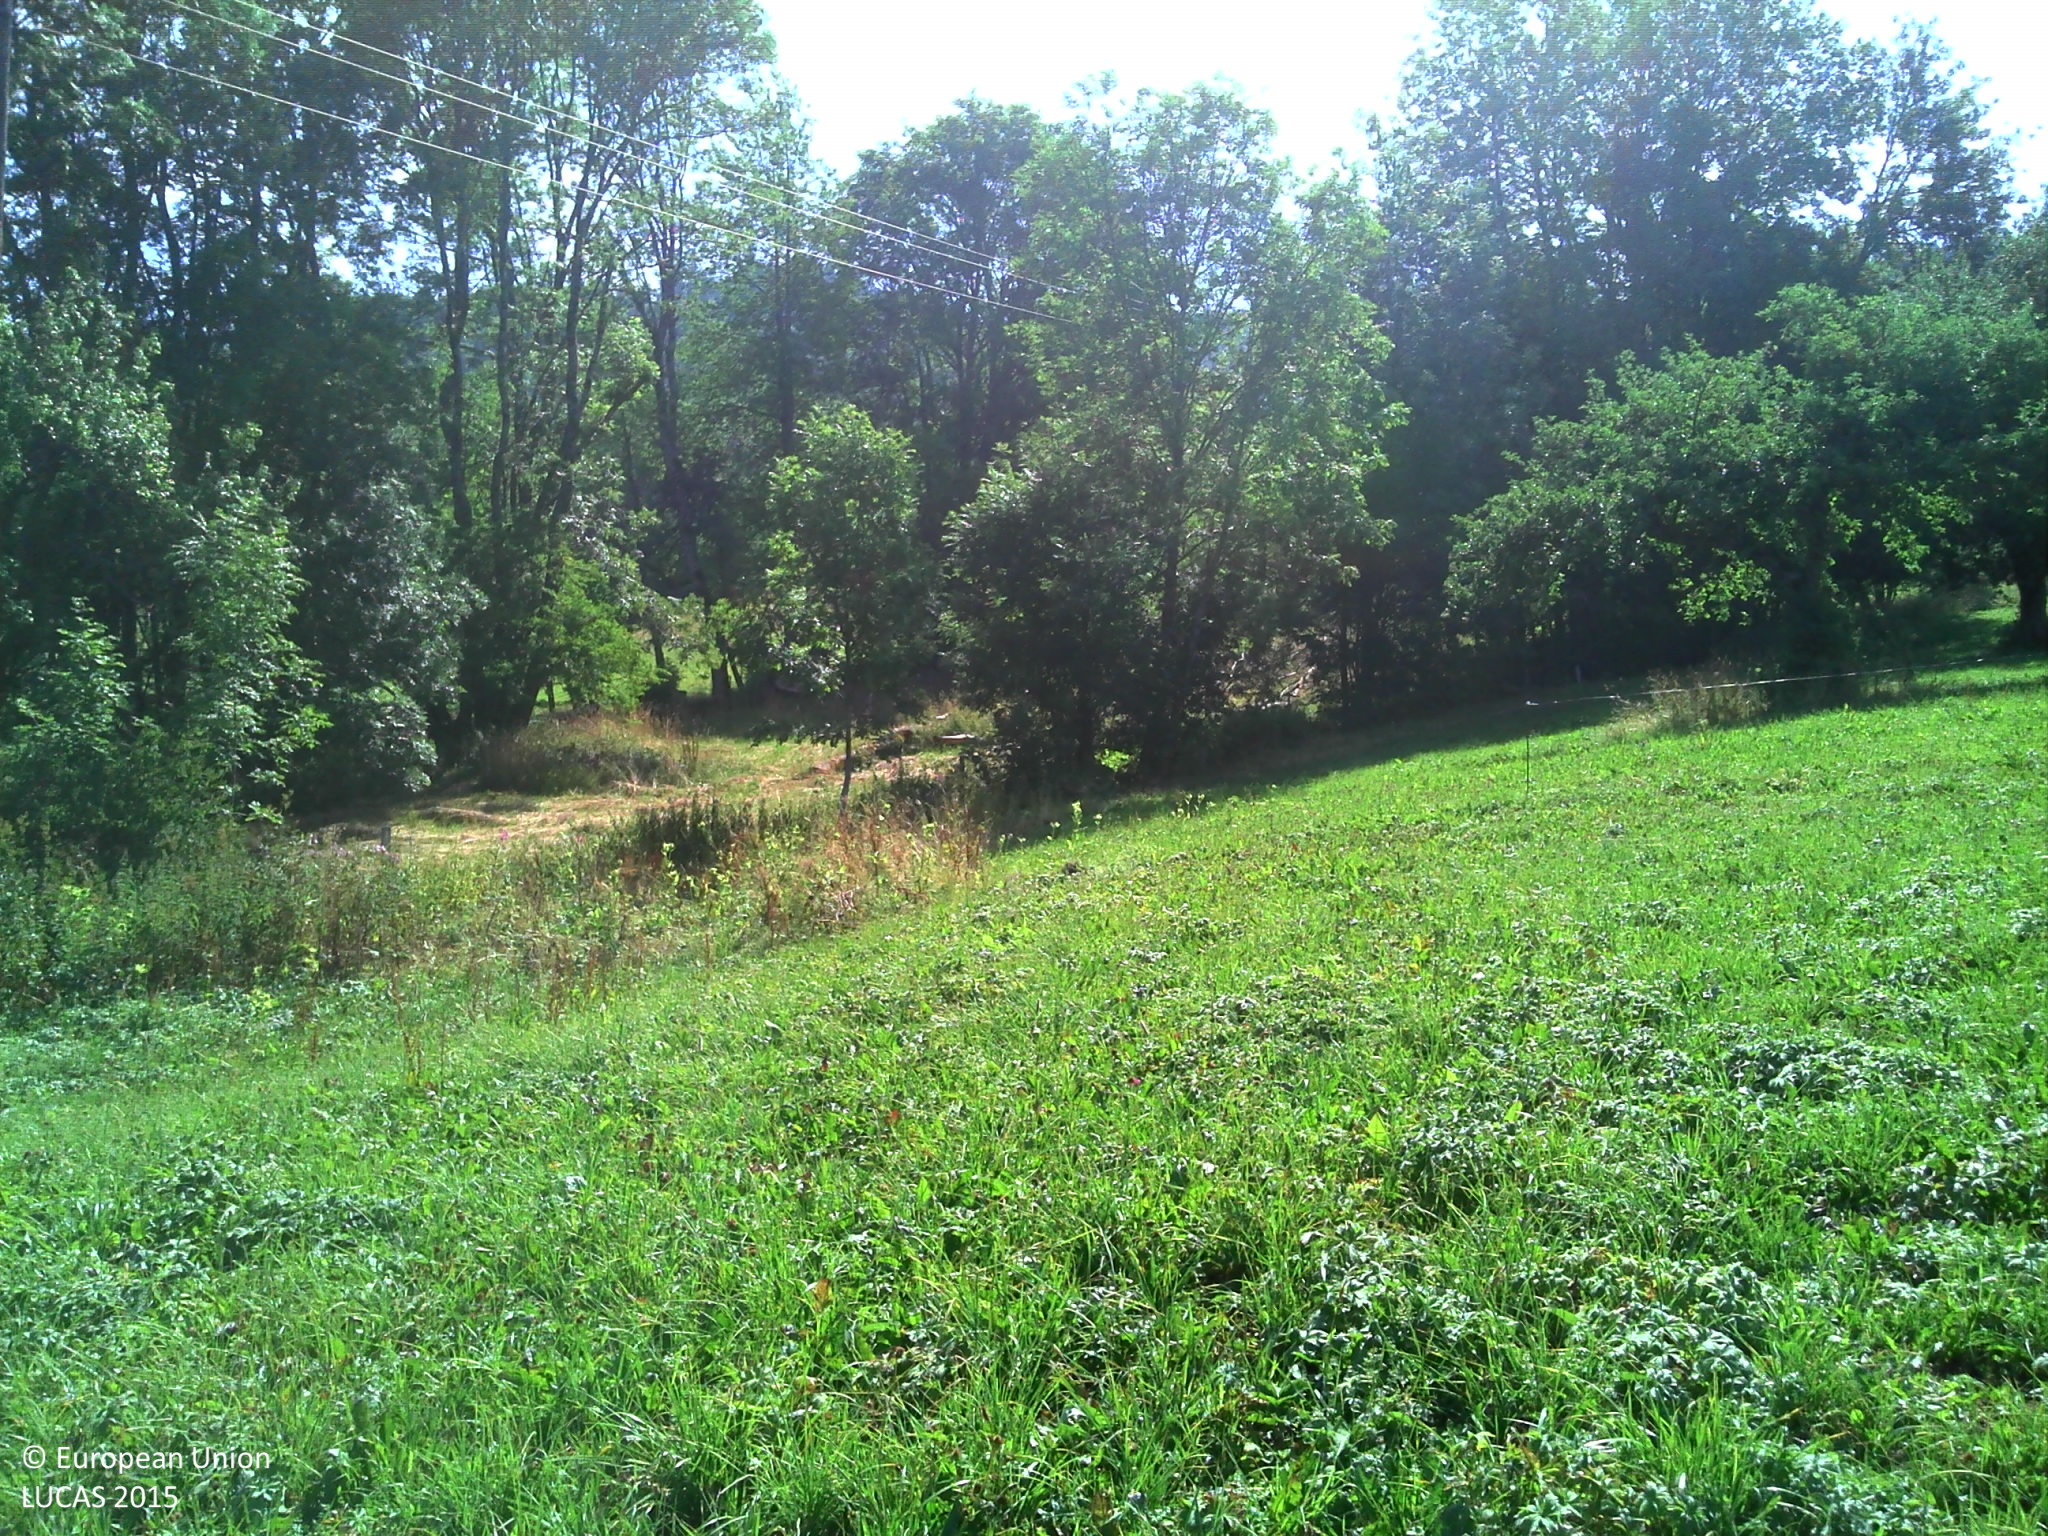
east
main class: Grassland
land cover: Grassland without tree/shrub cover
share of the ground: > 75 %
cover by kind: herbaceous plants 100 %
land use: Agriculture (excluding fallow land and kitchen gardens)
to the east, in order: Grassland without tree/shrub cover; Fences; Spontaneously vegetated surfaces; Electric lines; Spontaneously vegetated surfaces; Ditches and canals; Spontaneously vegetated surfaces; Fences; Broadleaved woodland; Fences; Grassland without tree/shrub cover; Fences; Grassland without tree/shrub cover; Fences; Broadleaved woodland; Grassland without tree/shrub cover
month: July
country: FR
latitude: 46.2018
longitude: 6.4396
